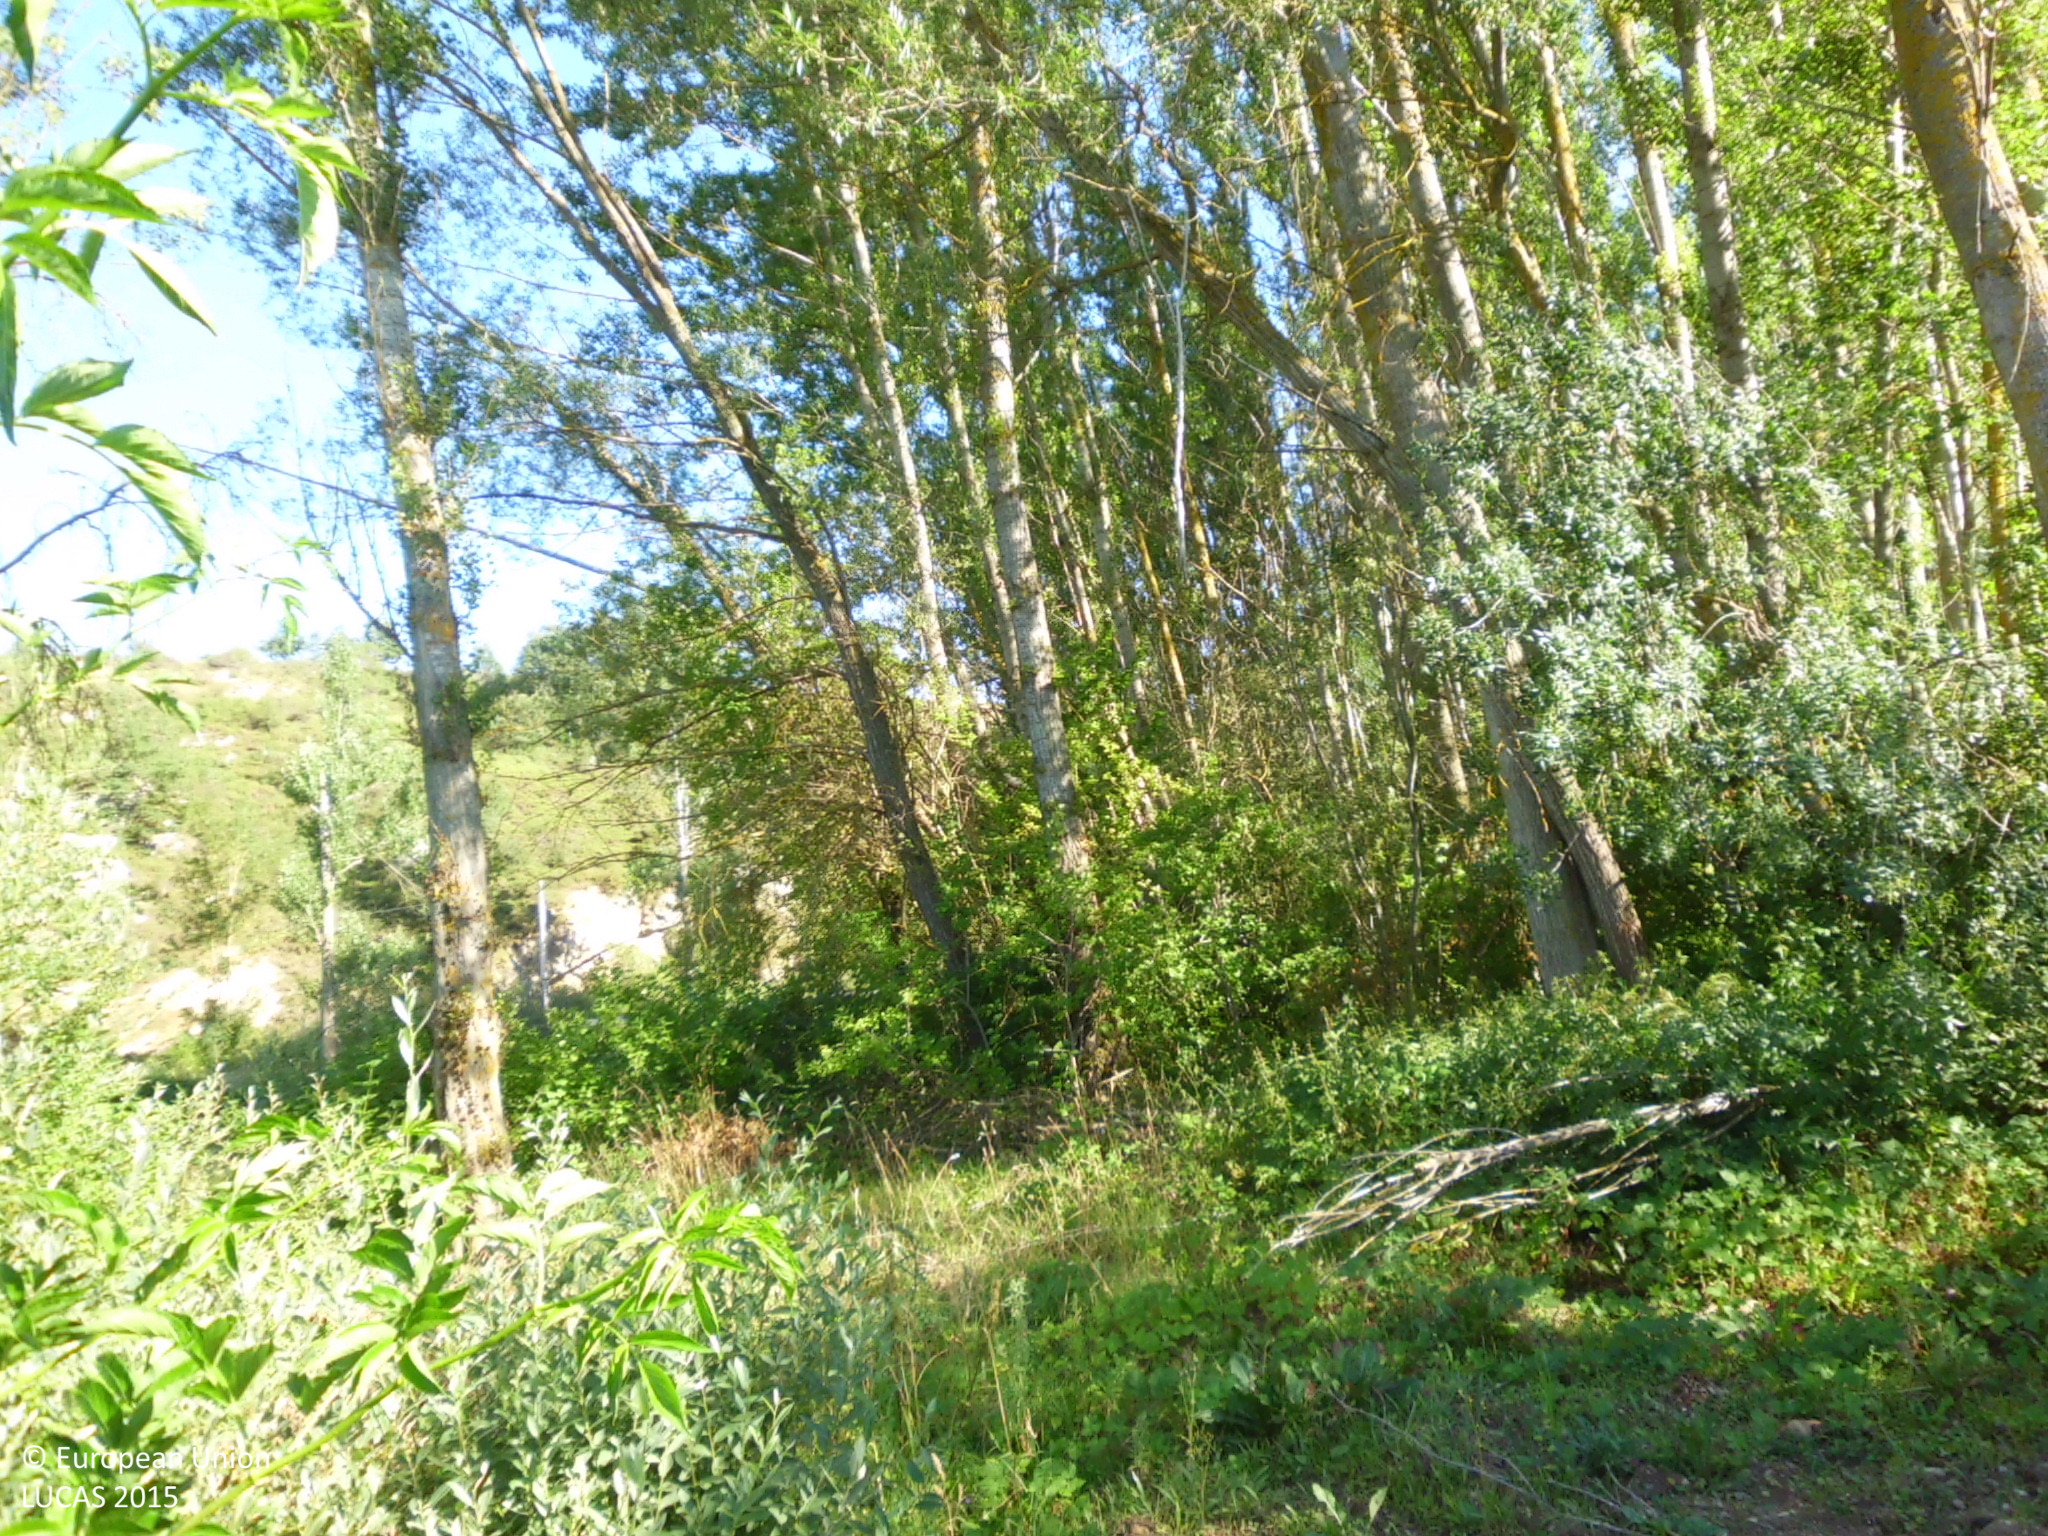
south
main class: Woodland
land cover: Broadleaved woodland
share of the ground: > 75 %
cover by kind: broadleaved forest trees 80 %, shrubs 20 %
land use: Semi-natural and natural areas not in use
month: July
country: ES
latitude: 42.8557
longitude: -4.4585
